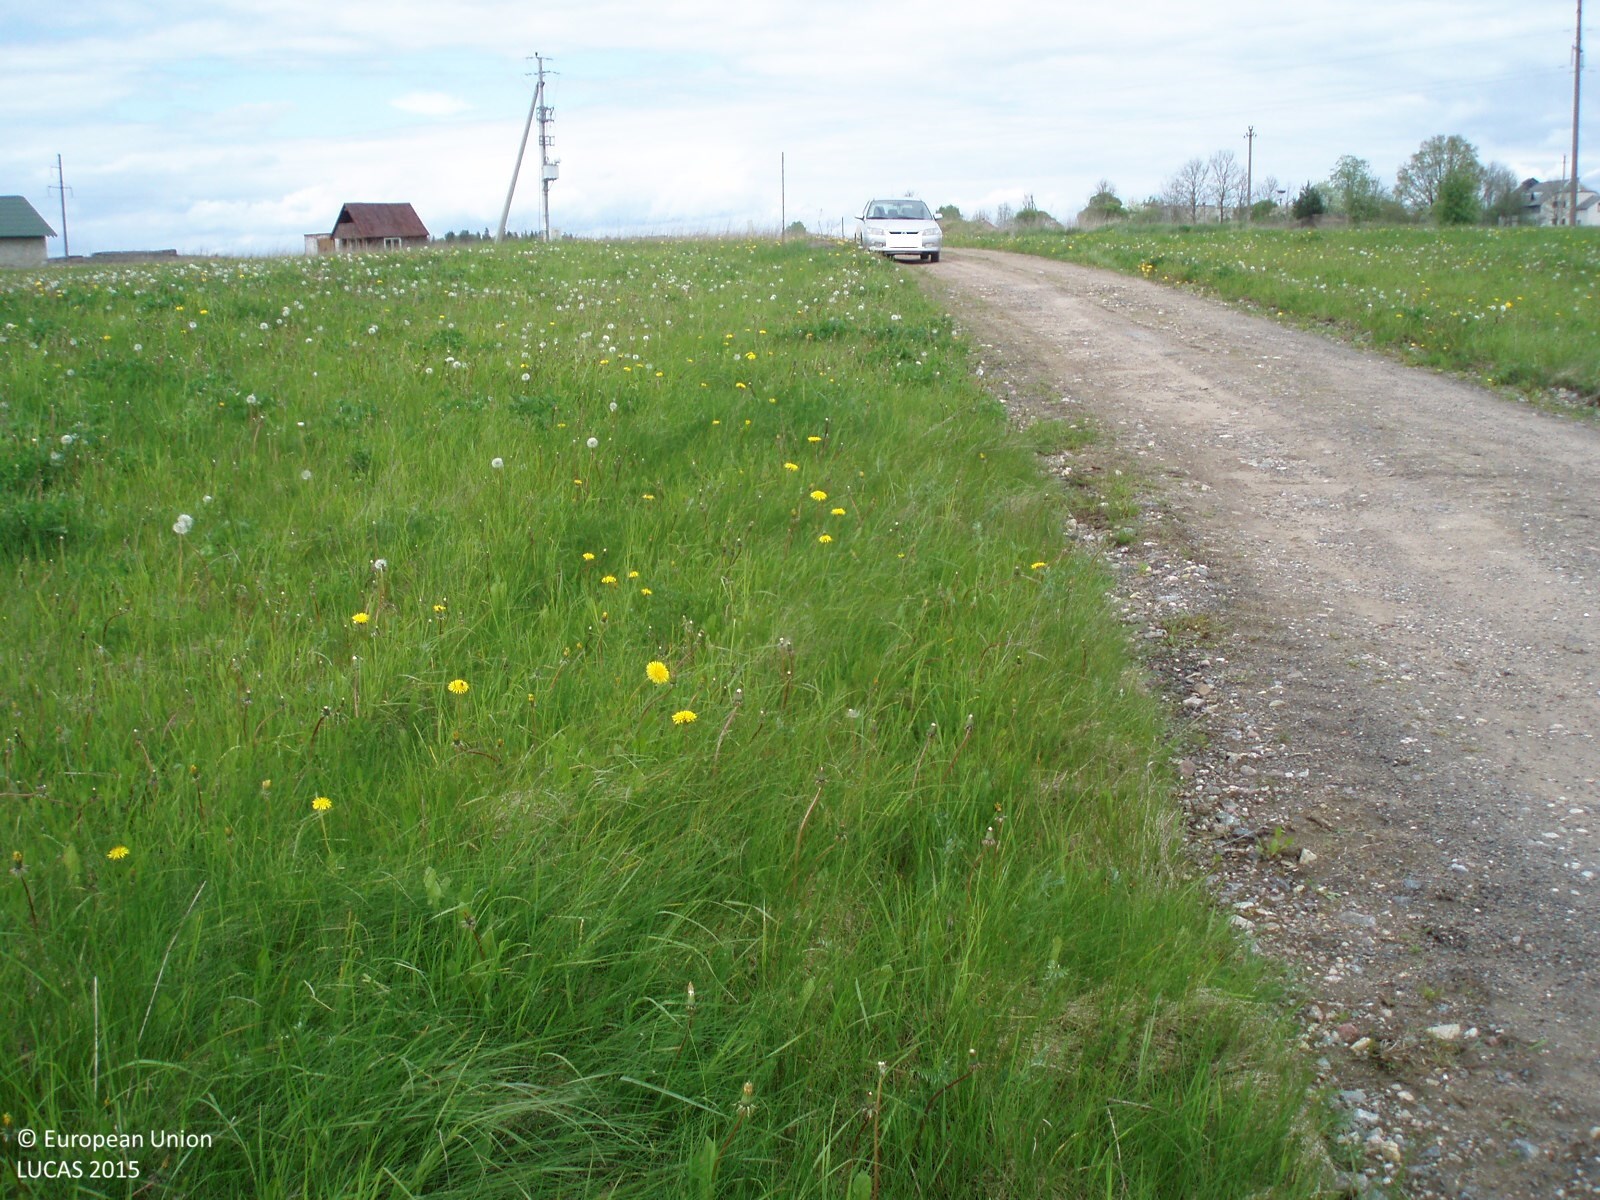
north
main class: Grassland
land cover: Grassland without tree/shrub cover
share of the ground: > 75 %
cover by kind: herbaceous plants 100 %
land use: Agriculture (excluding fallow land and kitchen gardens)
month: May
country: LT
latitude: 56.2746
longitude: 22.4111
